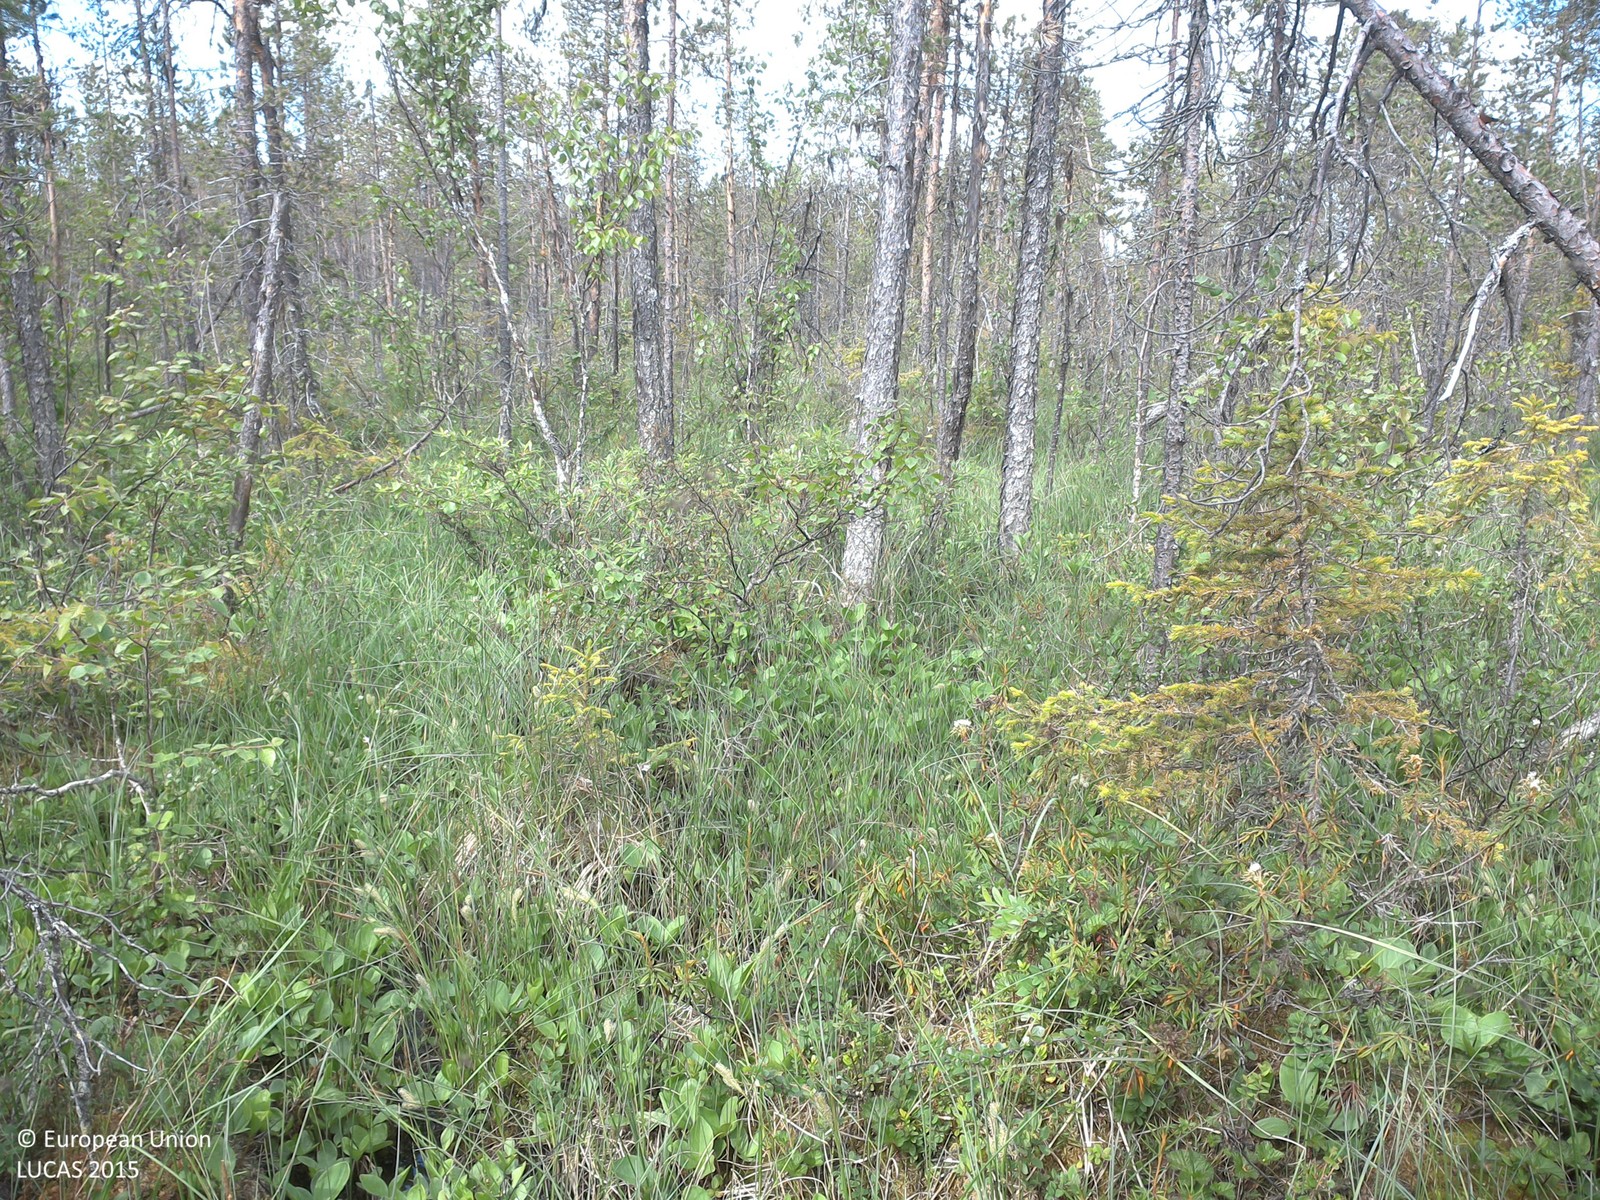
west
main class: Woodland
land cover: Pine dominated mixed woodland
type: boreal forest
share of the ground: 10 - 25 %
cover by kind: herbaceous plants 50 %, coniferous forest trees 15 %, shrubs 15 %, lichens and mosses 10 %, broadleaved forest trees 5 %
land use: Forestry
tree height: > 5 m
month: July
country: SE
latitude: 67.2988
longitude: 22.7575
